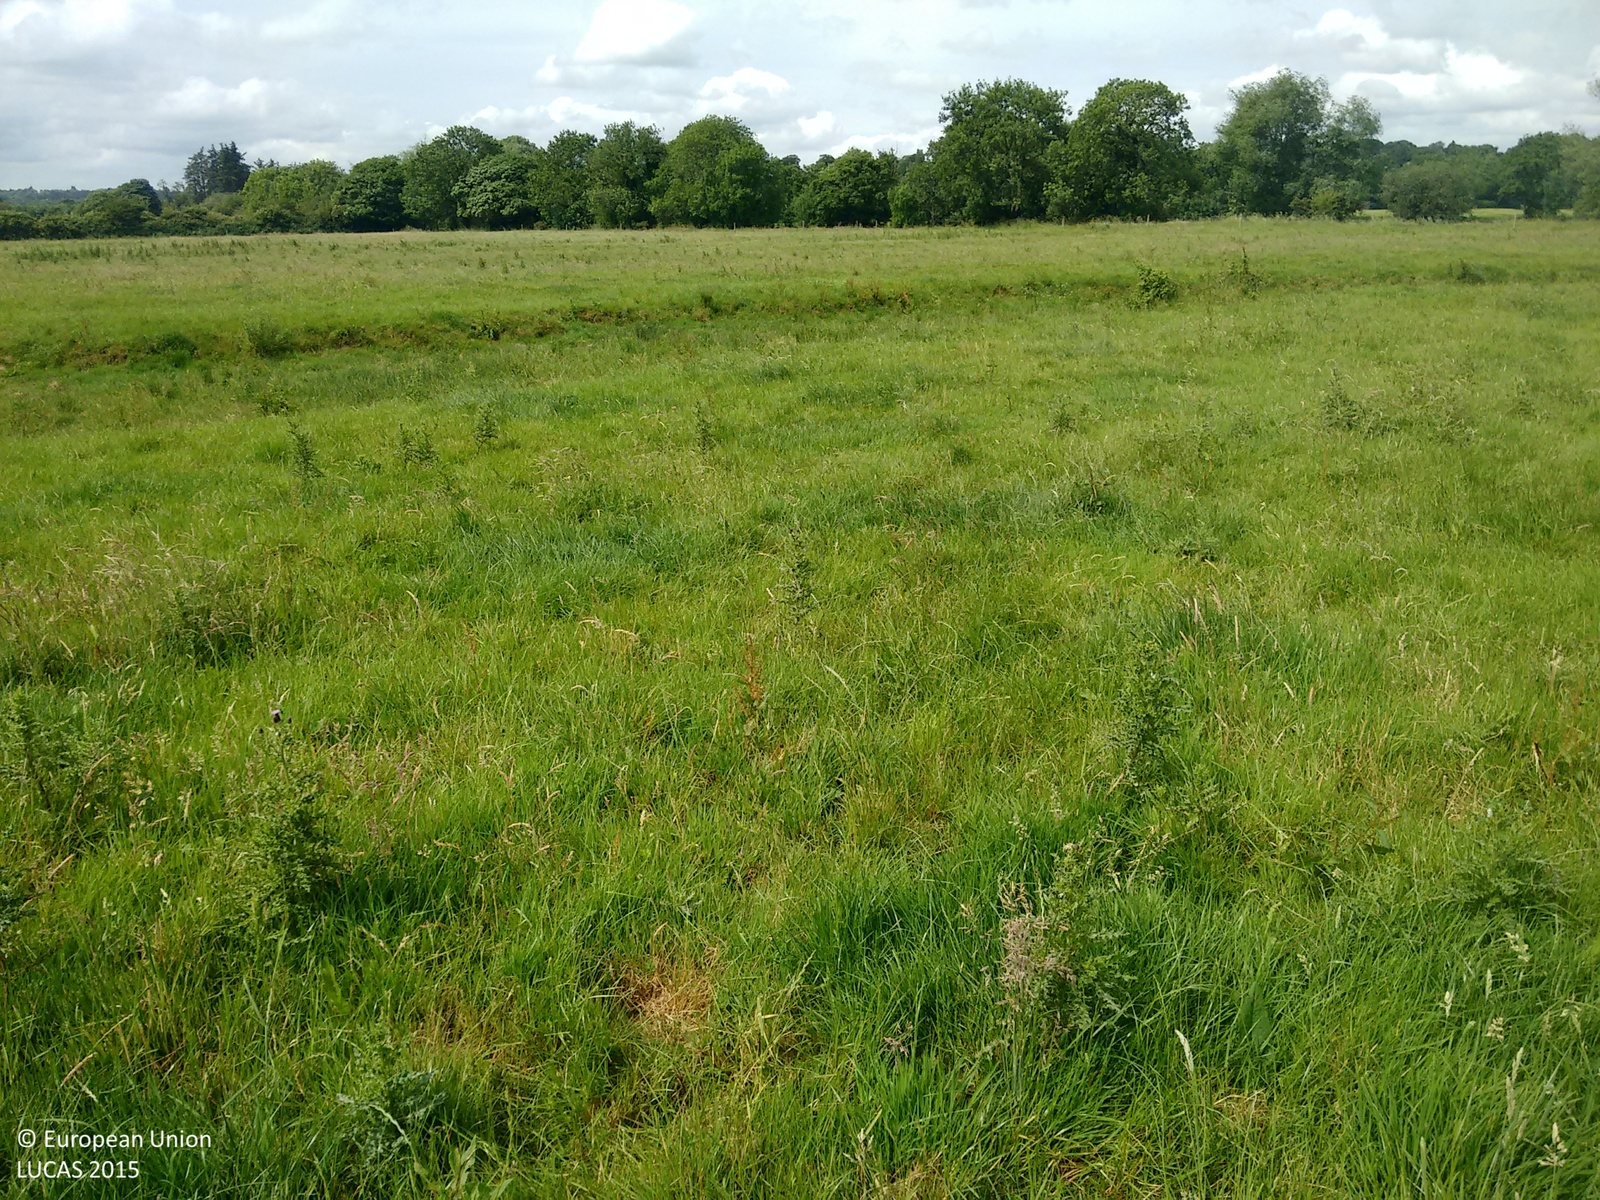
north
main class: Grassland
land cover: Grassland without tree/shrub cover
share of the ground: > 75 %
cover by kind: herbaceous plants 100 %
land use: Agriculture (excluding fallow land and kitchen gardens)
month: July
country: IE
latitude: 52.1340
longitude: -8.8946
